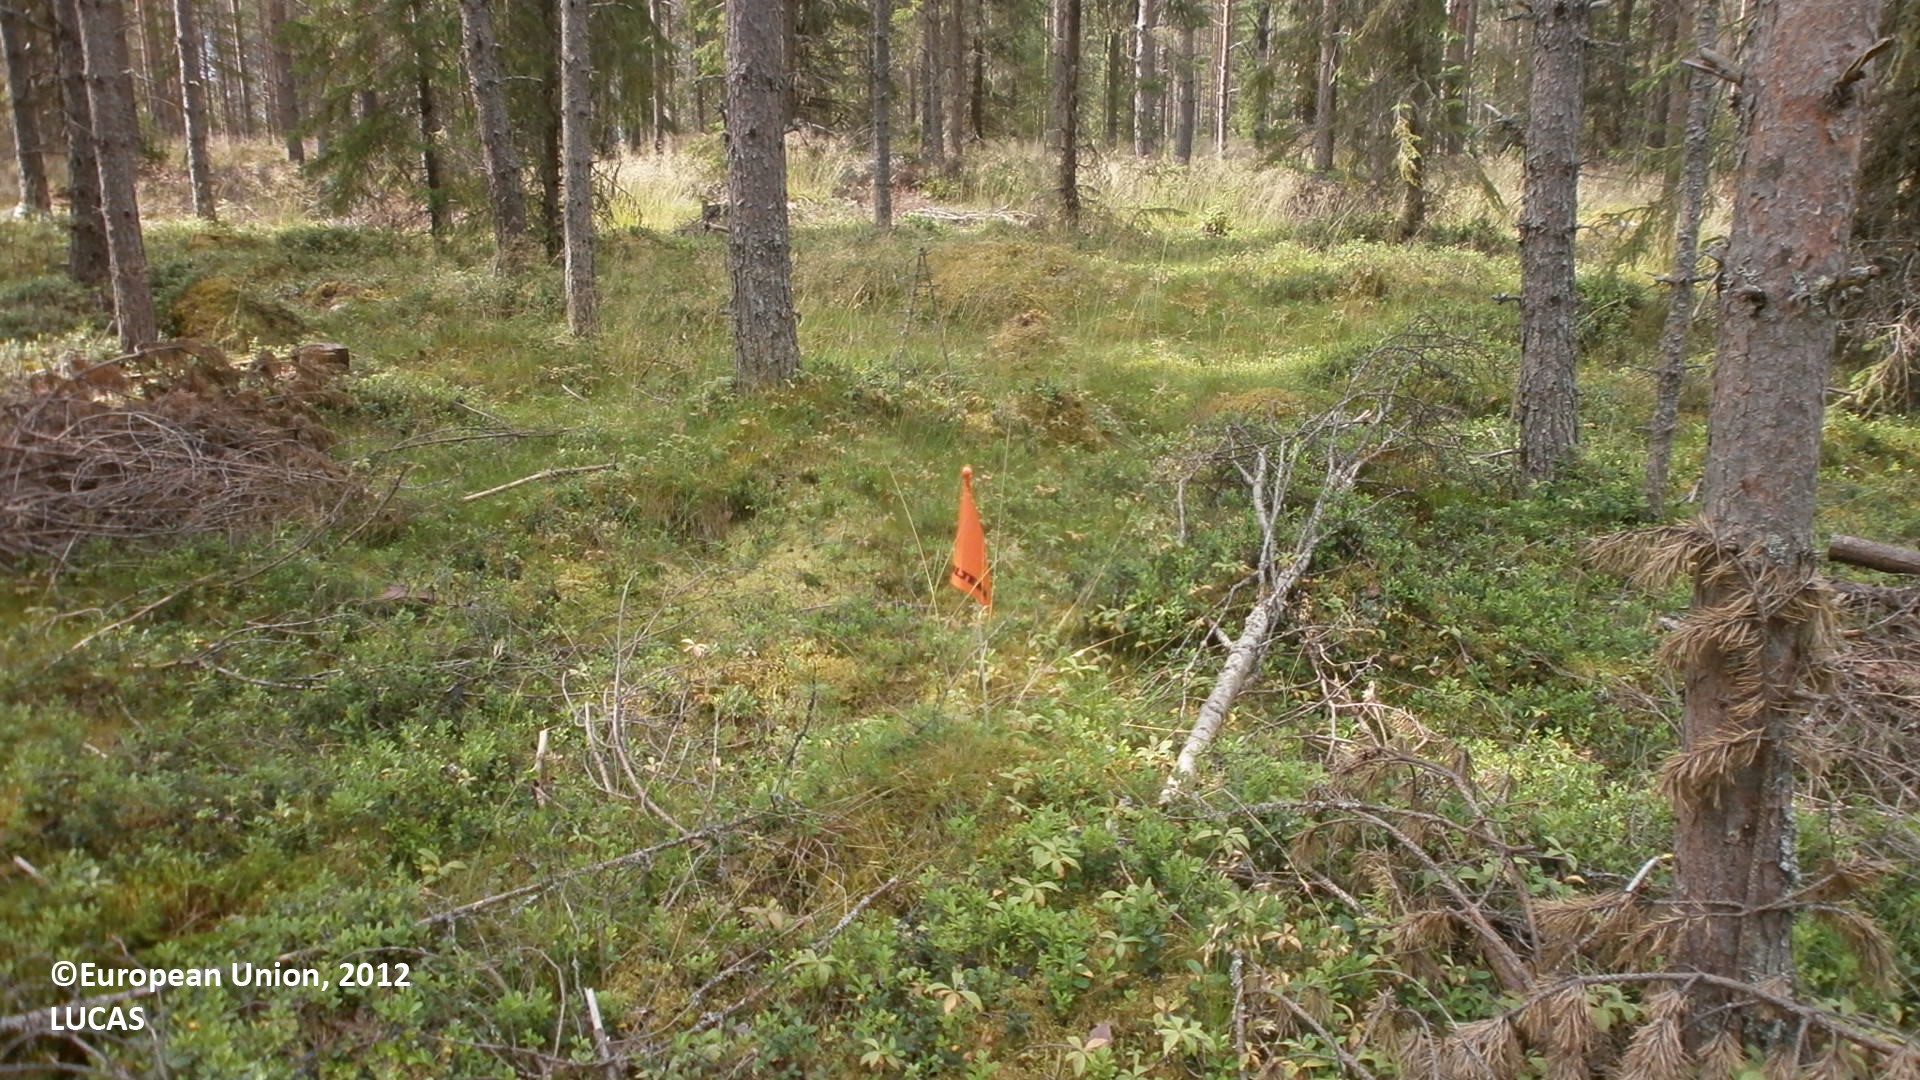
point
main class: Woodland
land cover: Pine dominated coniferous woodland
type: boreal forest
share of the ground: 50 - 75 %
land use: Forestry
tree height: > 5 m
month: July
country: FI
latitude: 64.0592
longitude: 23.8931
